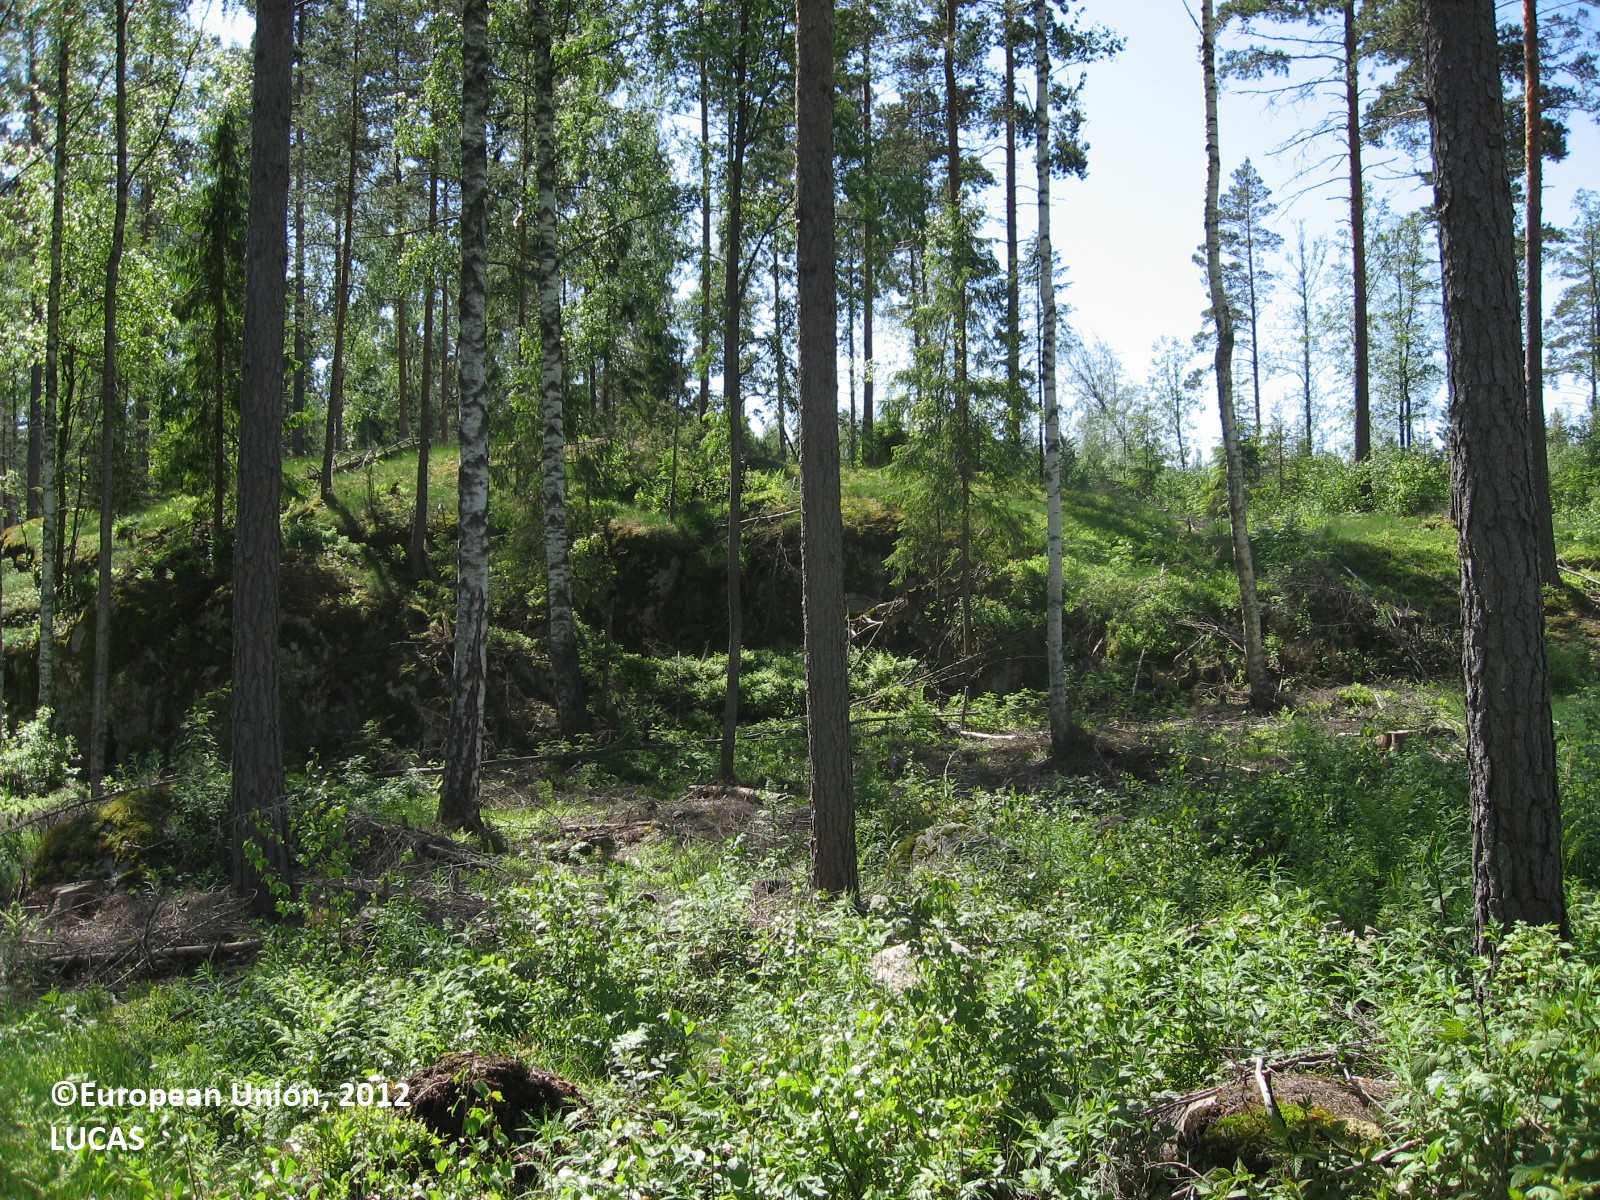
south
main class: Woodland
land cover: Pine dominated mixed woodland
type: boreal forest
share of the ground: 25 - 50 %
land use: Forestry
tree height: > 5 m
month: June
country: FI
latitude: 60.3742
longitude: 25.4163
